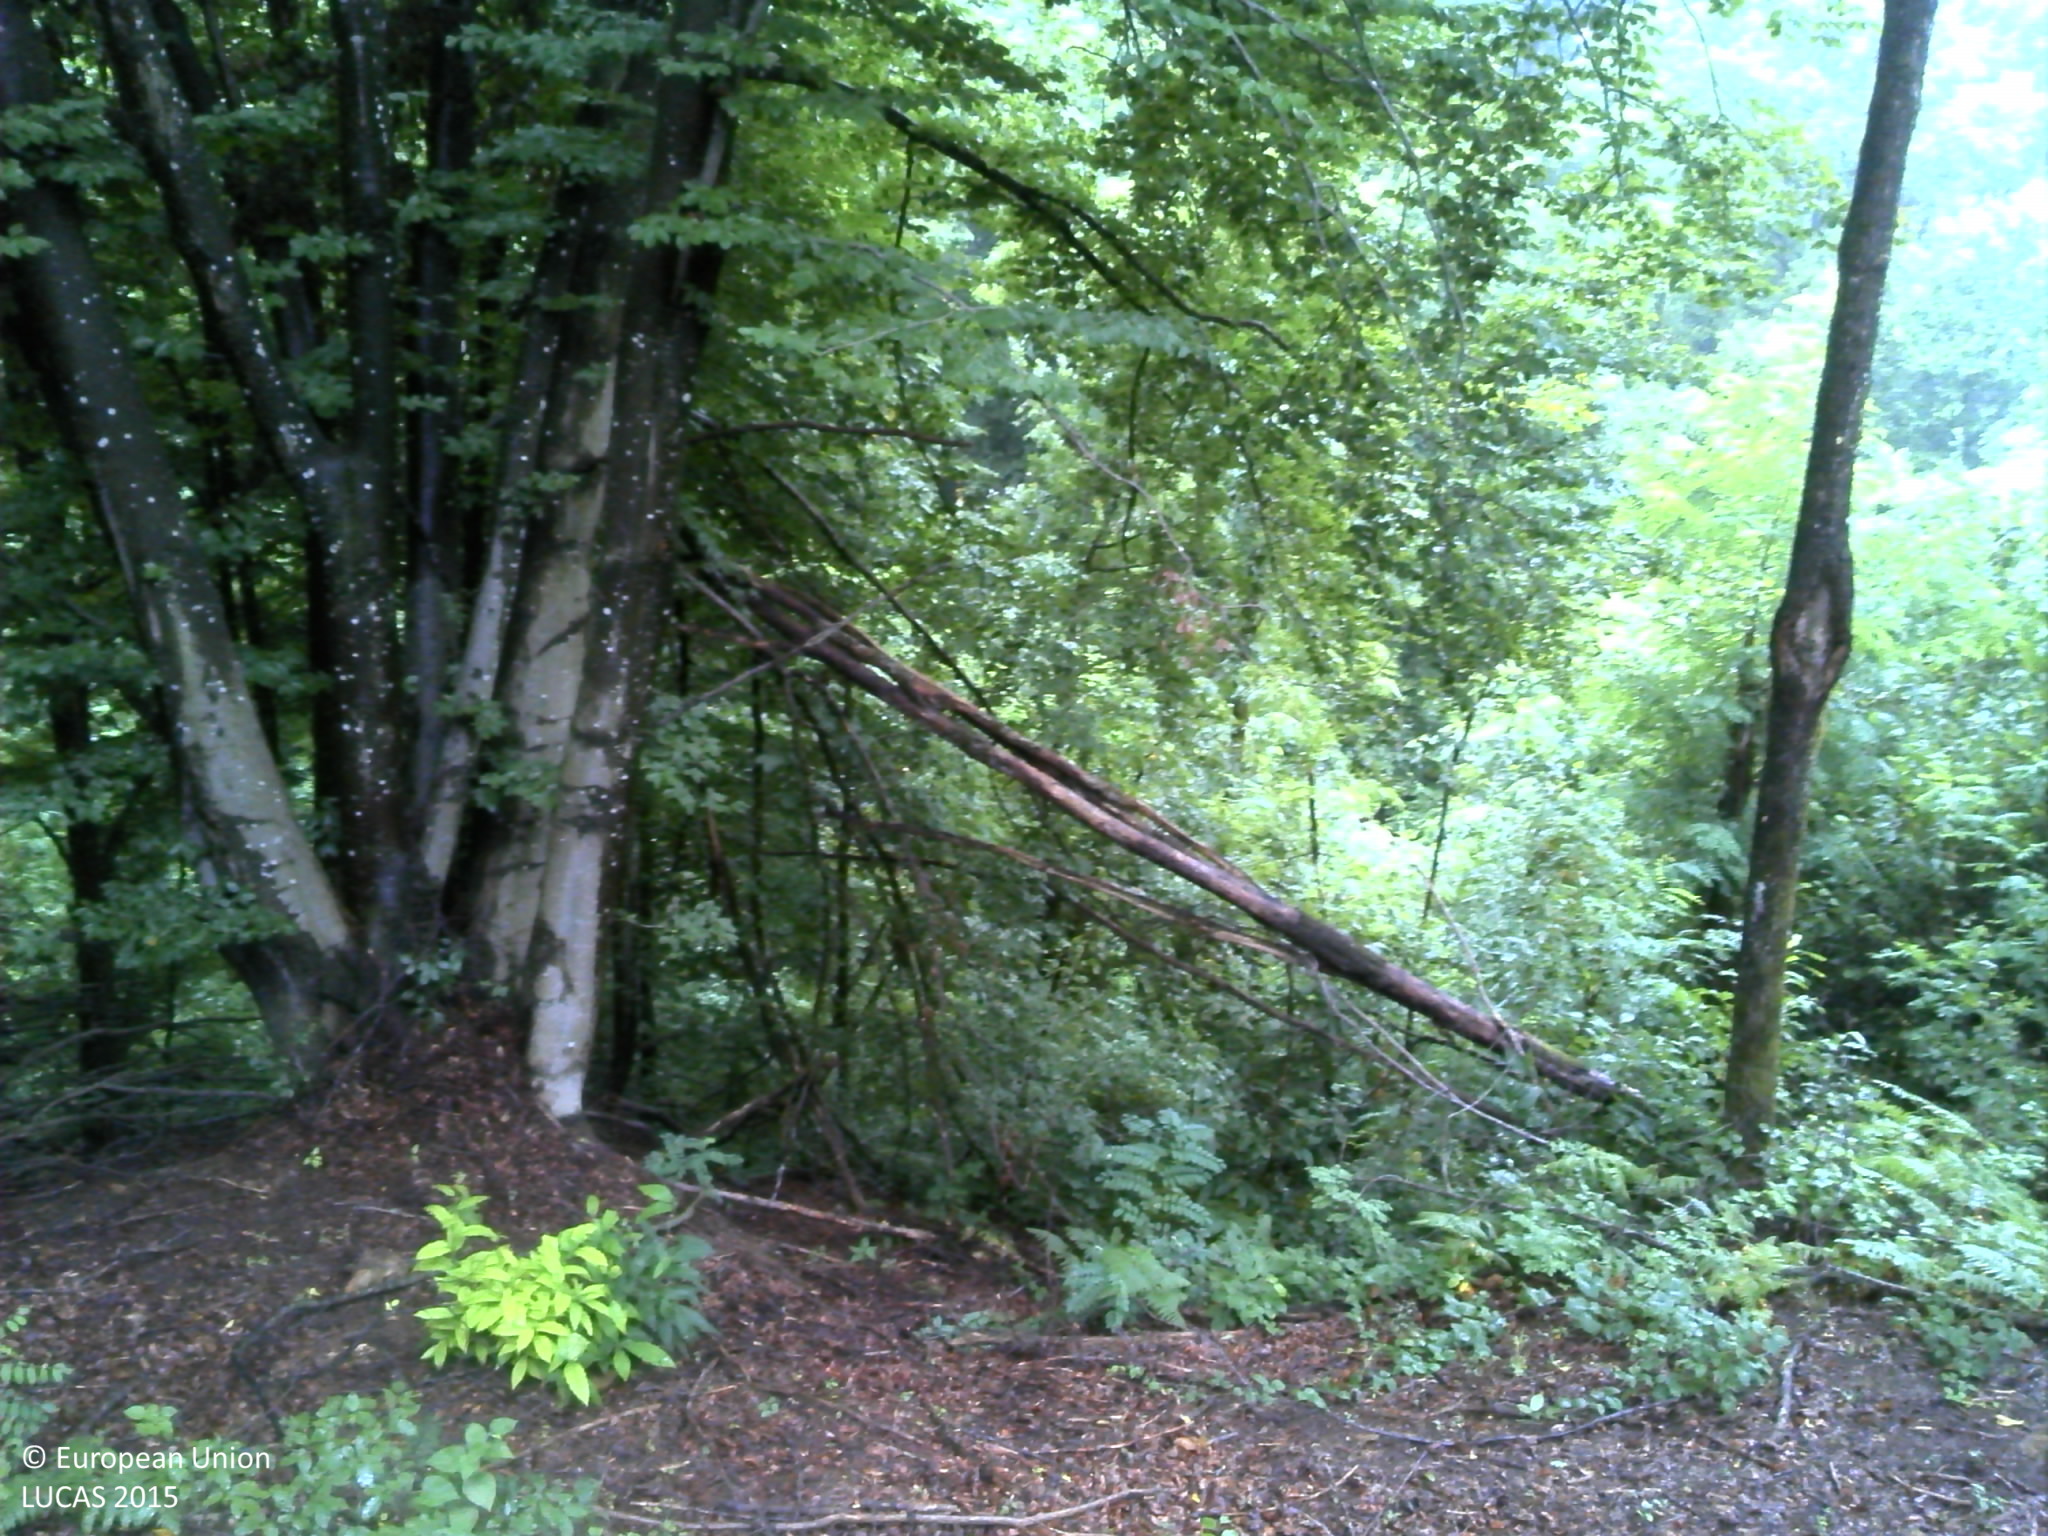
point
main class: Woodland
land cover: Broadleaved woodland
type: beech forest
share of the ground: > 75 %
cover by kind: broadleaved forest trees 100 %
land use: Forestry
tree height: > 5 m
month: August
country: HR
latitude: 45.4761
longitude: 15.7146
